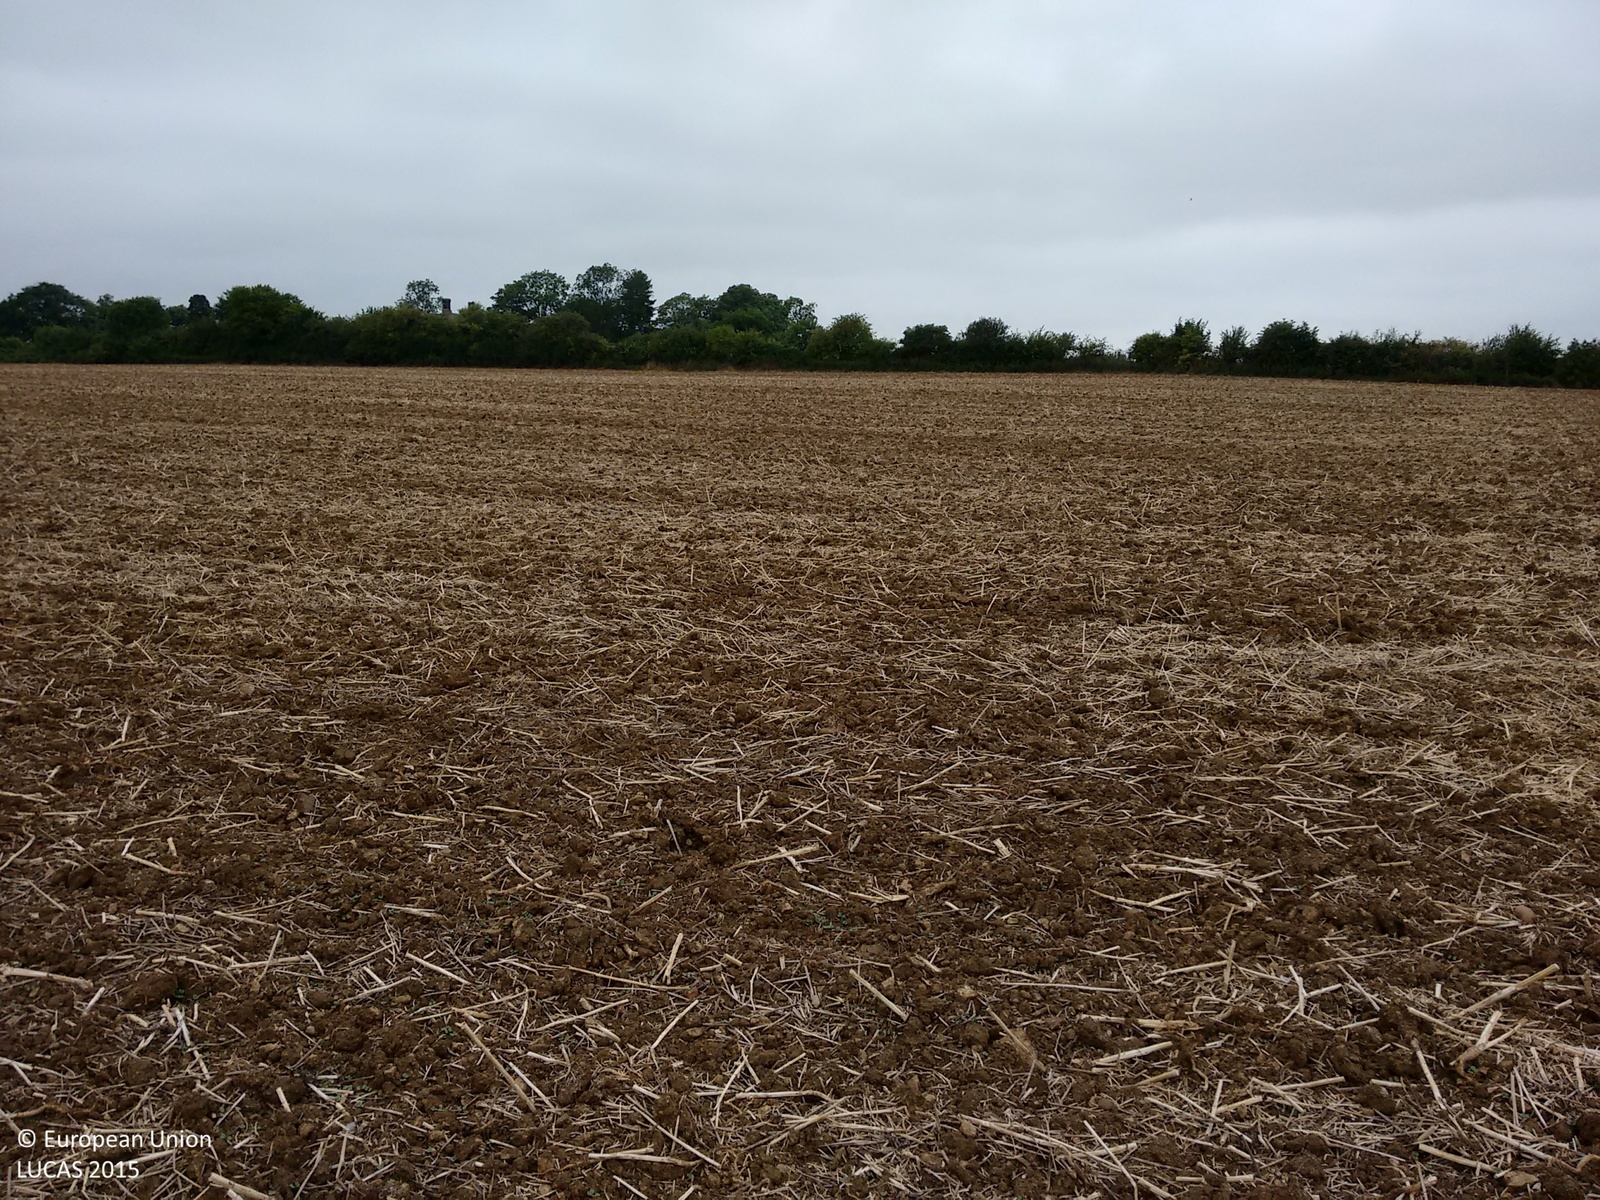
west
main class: Cropland
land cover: Rape and turnip rape
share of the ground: < 10 %
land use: Agriculture (excluding fallow land and kitchen gardens)
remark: Harvested field
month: August
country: GB
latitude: 52.2889
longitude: -0.7285
